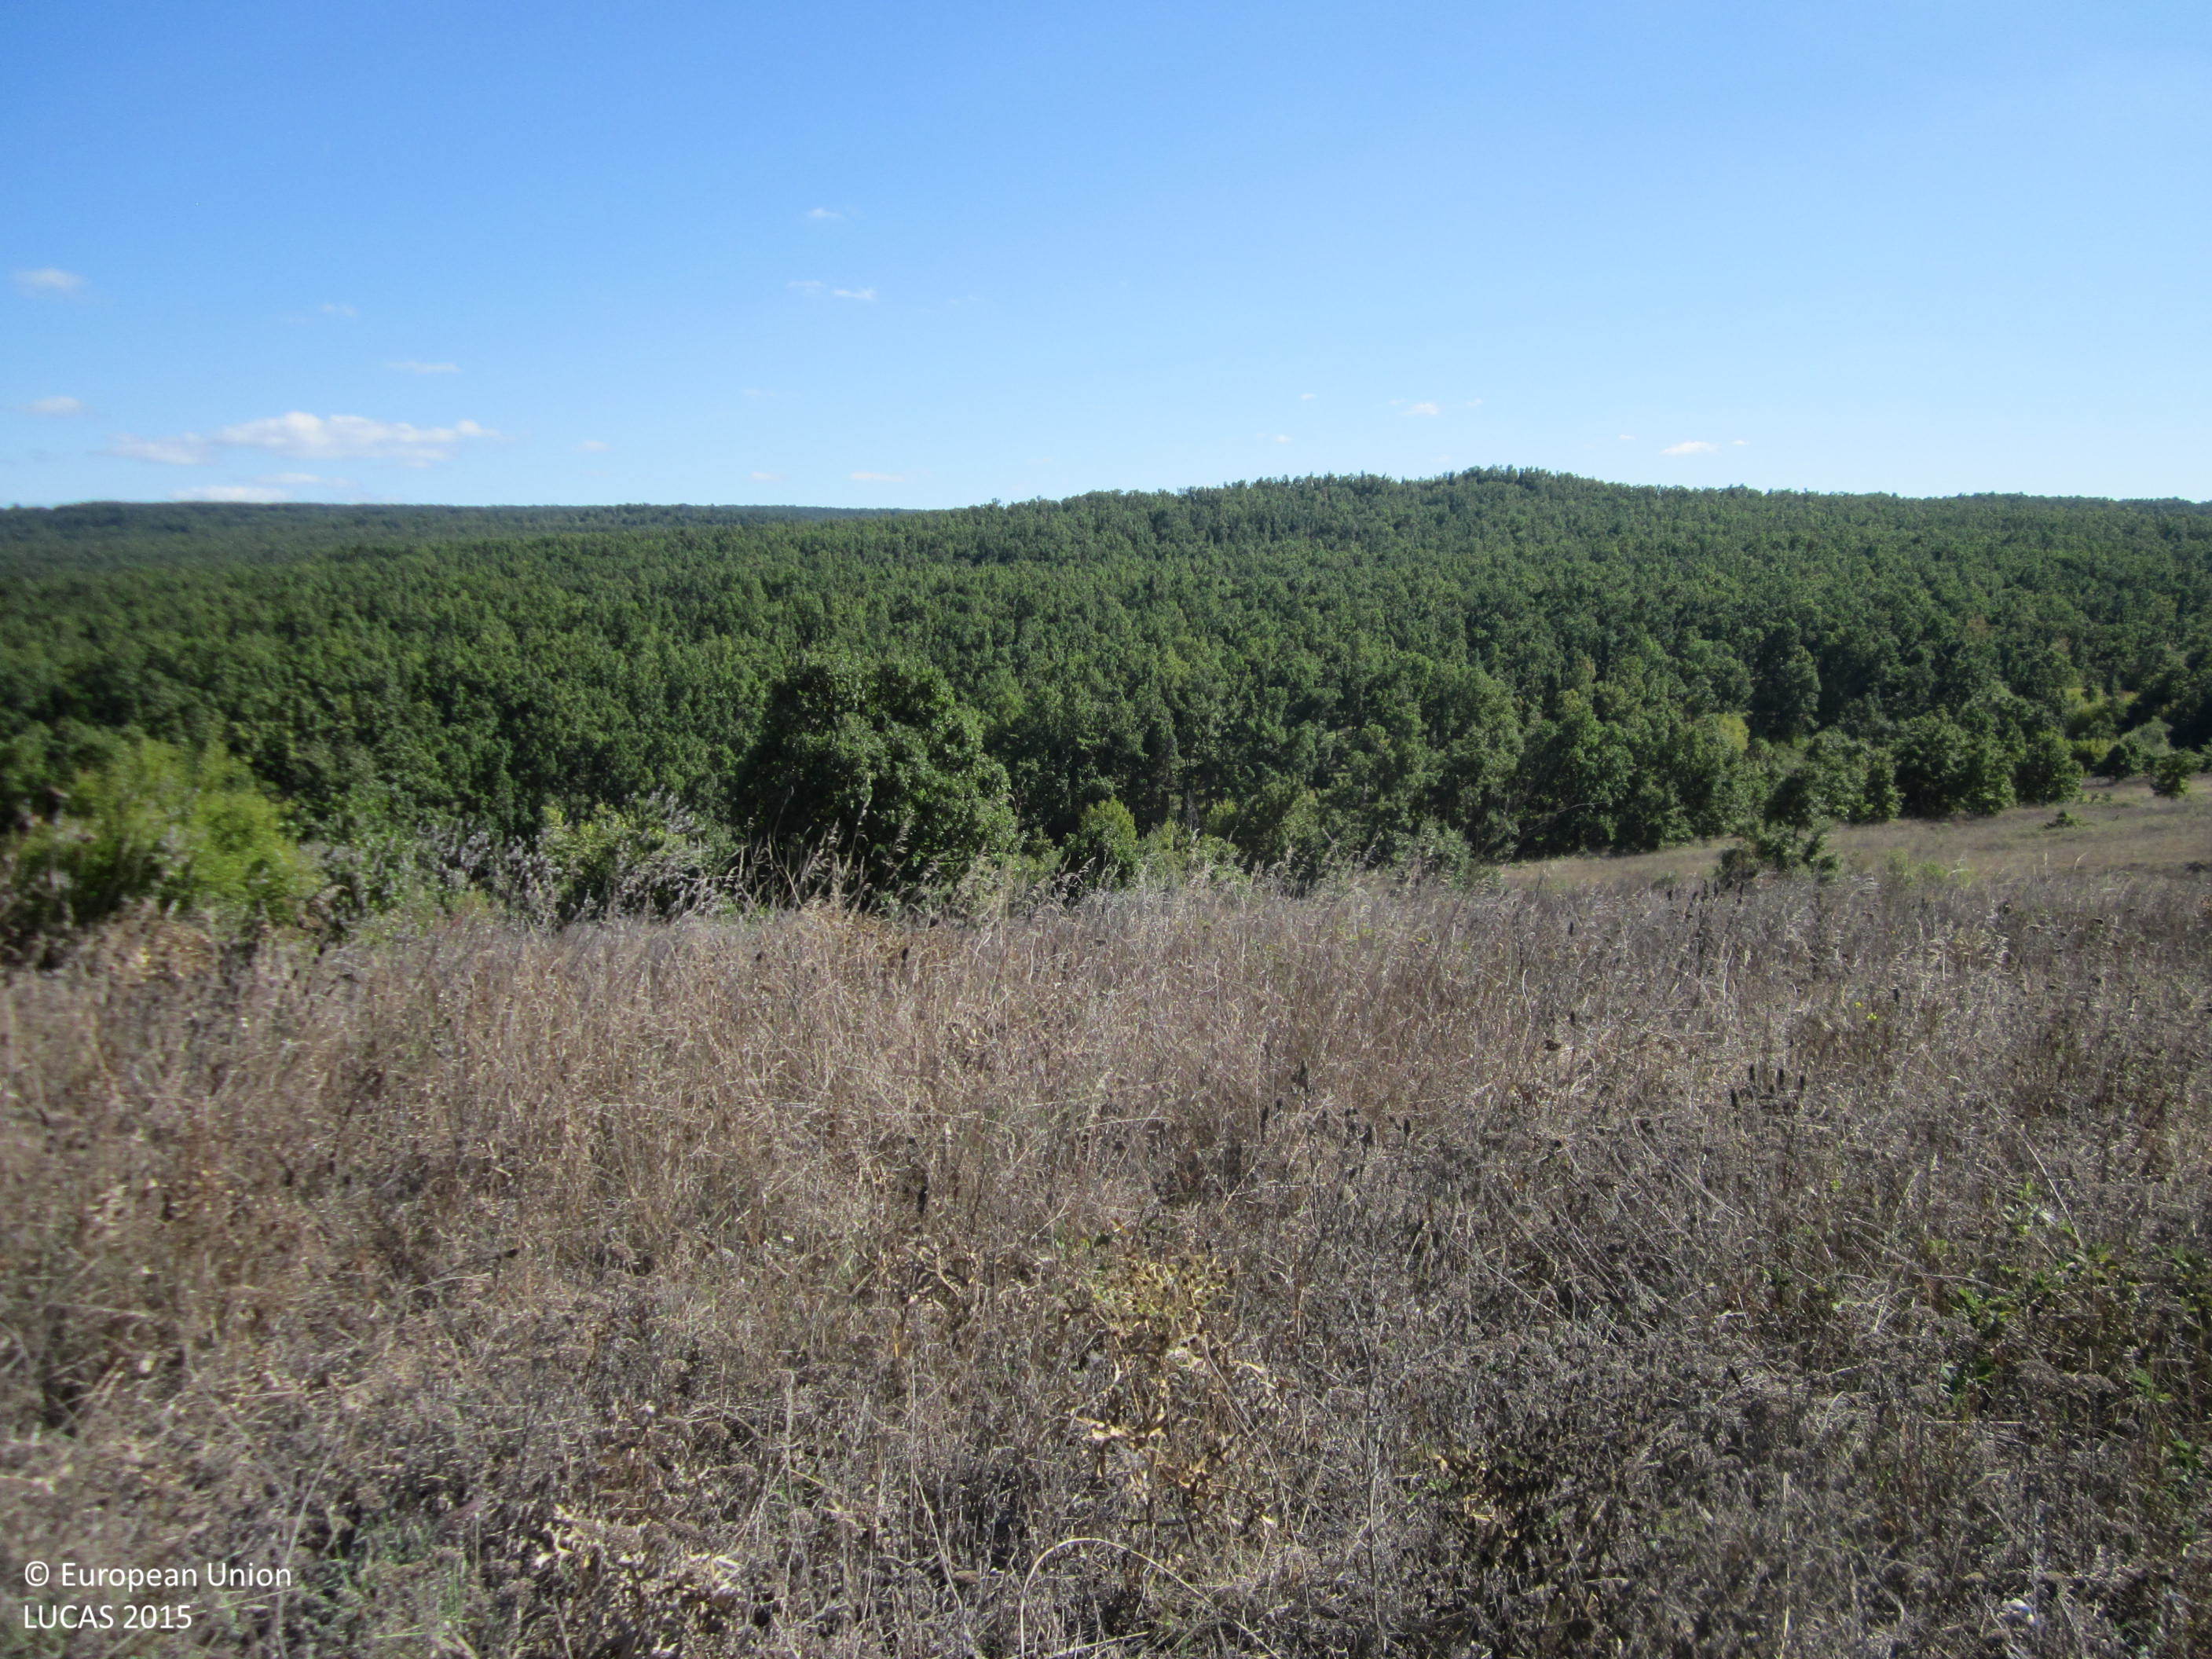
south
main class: Grassland
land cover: Grassland with sparse tree/shrub cover
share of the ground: > 75 %
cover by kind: herbaceous plants 90 %, broadleaved forest trees 5 %, shrubs 5 %
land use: Agriculture (excluding fallow land and kitchen gardens)
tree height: < 5 m
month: September
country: BG
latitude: 42.1496
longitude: 27.1792
